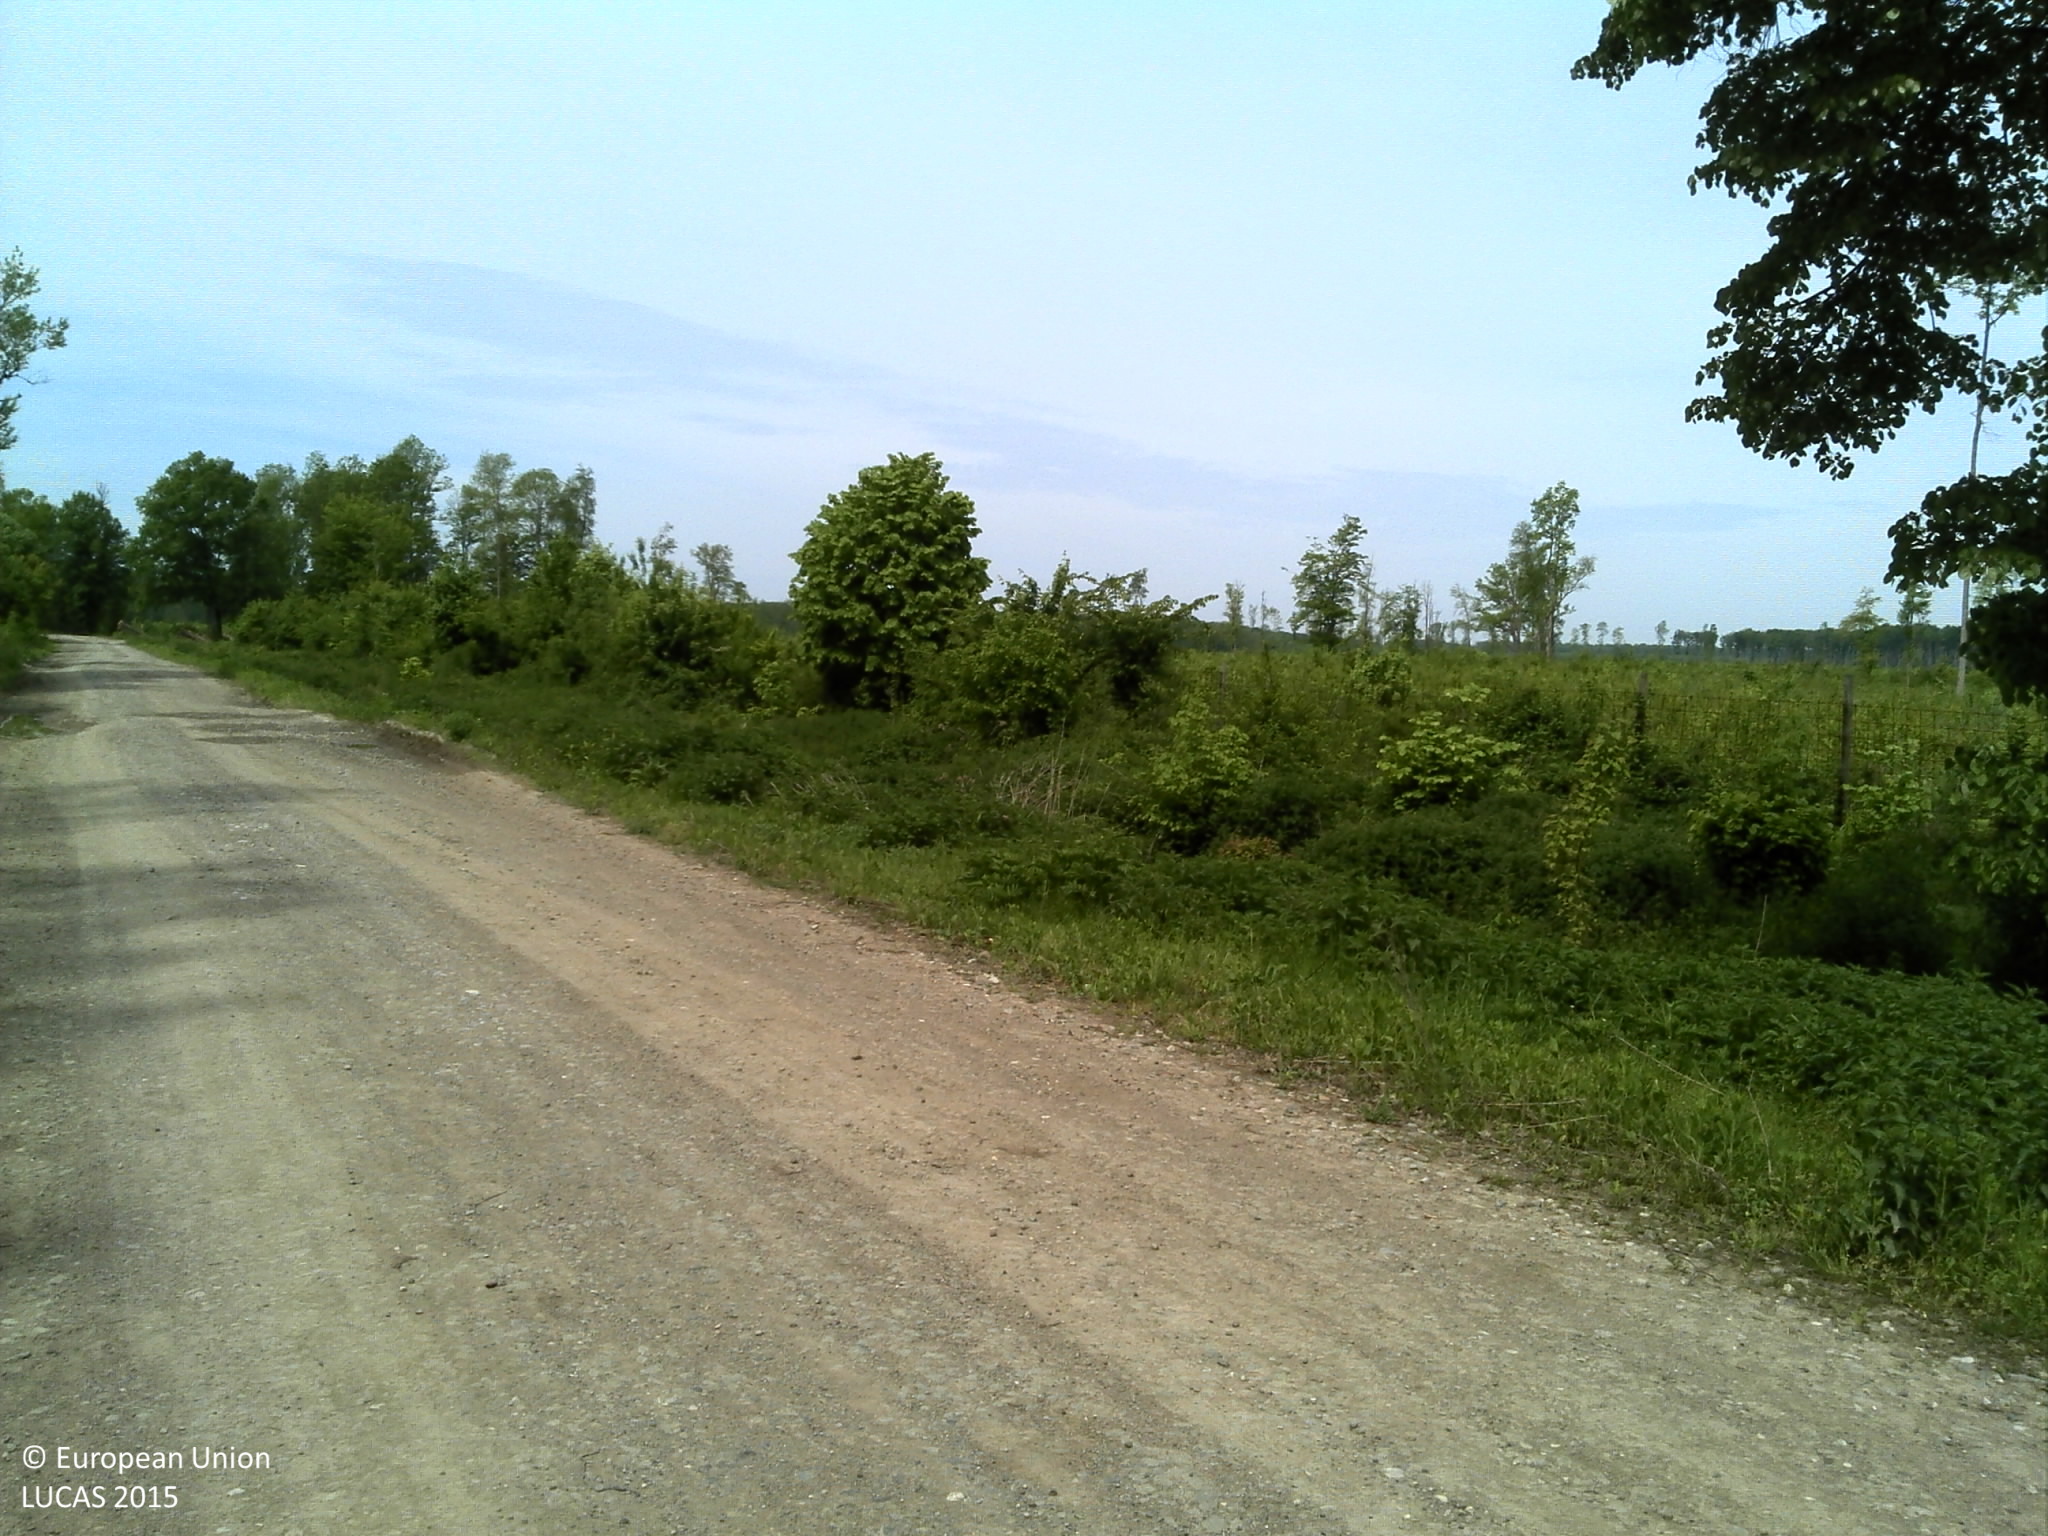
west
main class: Grassland
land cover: Spontaneously vegetated surfaces
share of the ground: > 75 %
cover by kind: herbaceous plants 65 %, unconsolidated bare surface 30 %, shrubs 5 %
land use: Forestry
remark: Clear cut
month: May
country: HR
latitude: 45.0390
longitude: 18.8800
